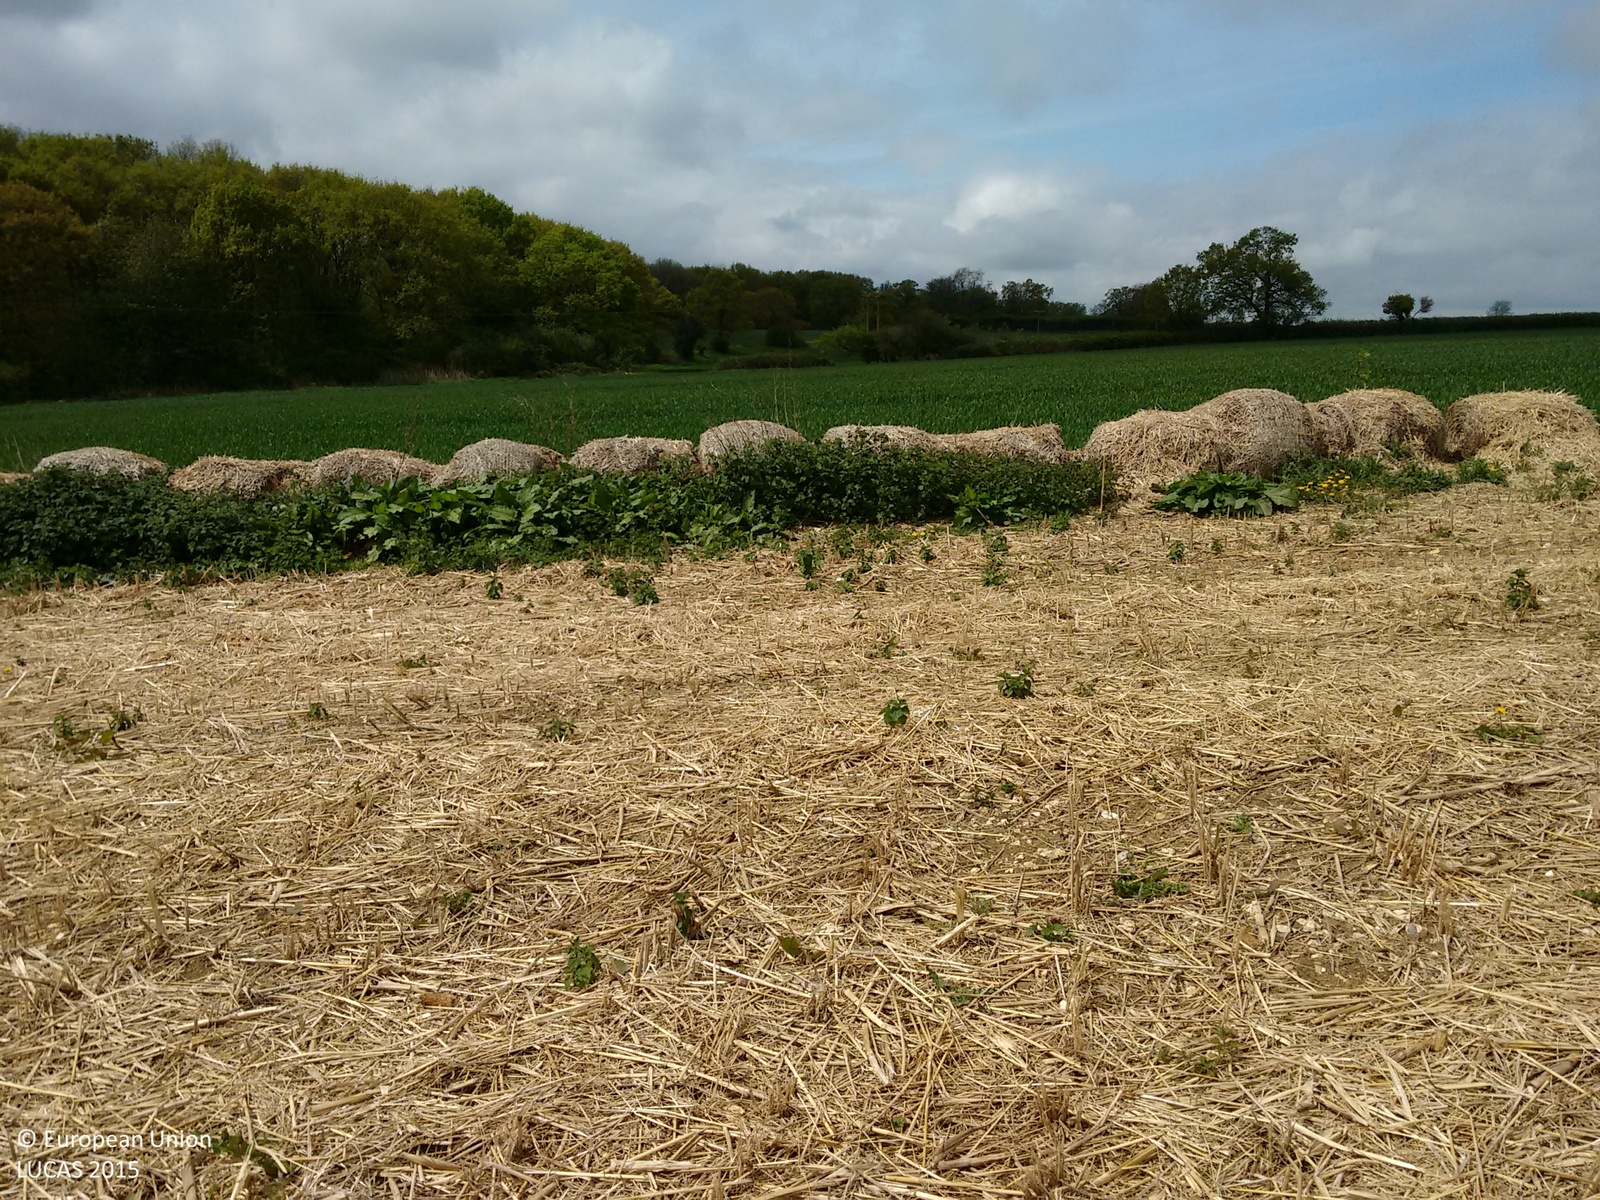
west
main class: Grassland
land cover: Spontaneously vegetated surfaces
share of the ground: < 10 %
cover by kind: unconsolidated bare surface 80 %, herbaceous plants 20 %
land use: Fallow land
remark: Harvested field
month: May
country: GB
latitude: 51.8758
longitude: -0.4820
